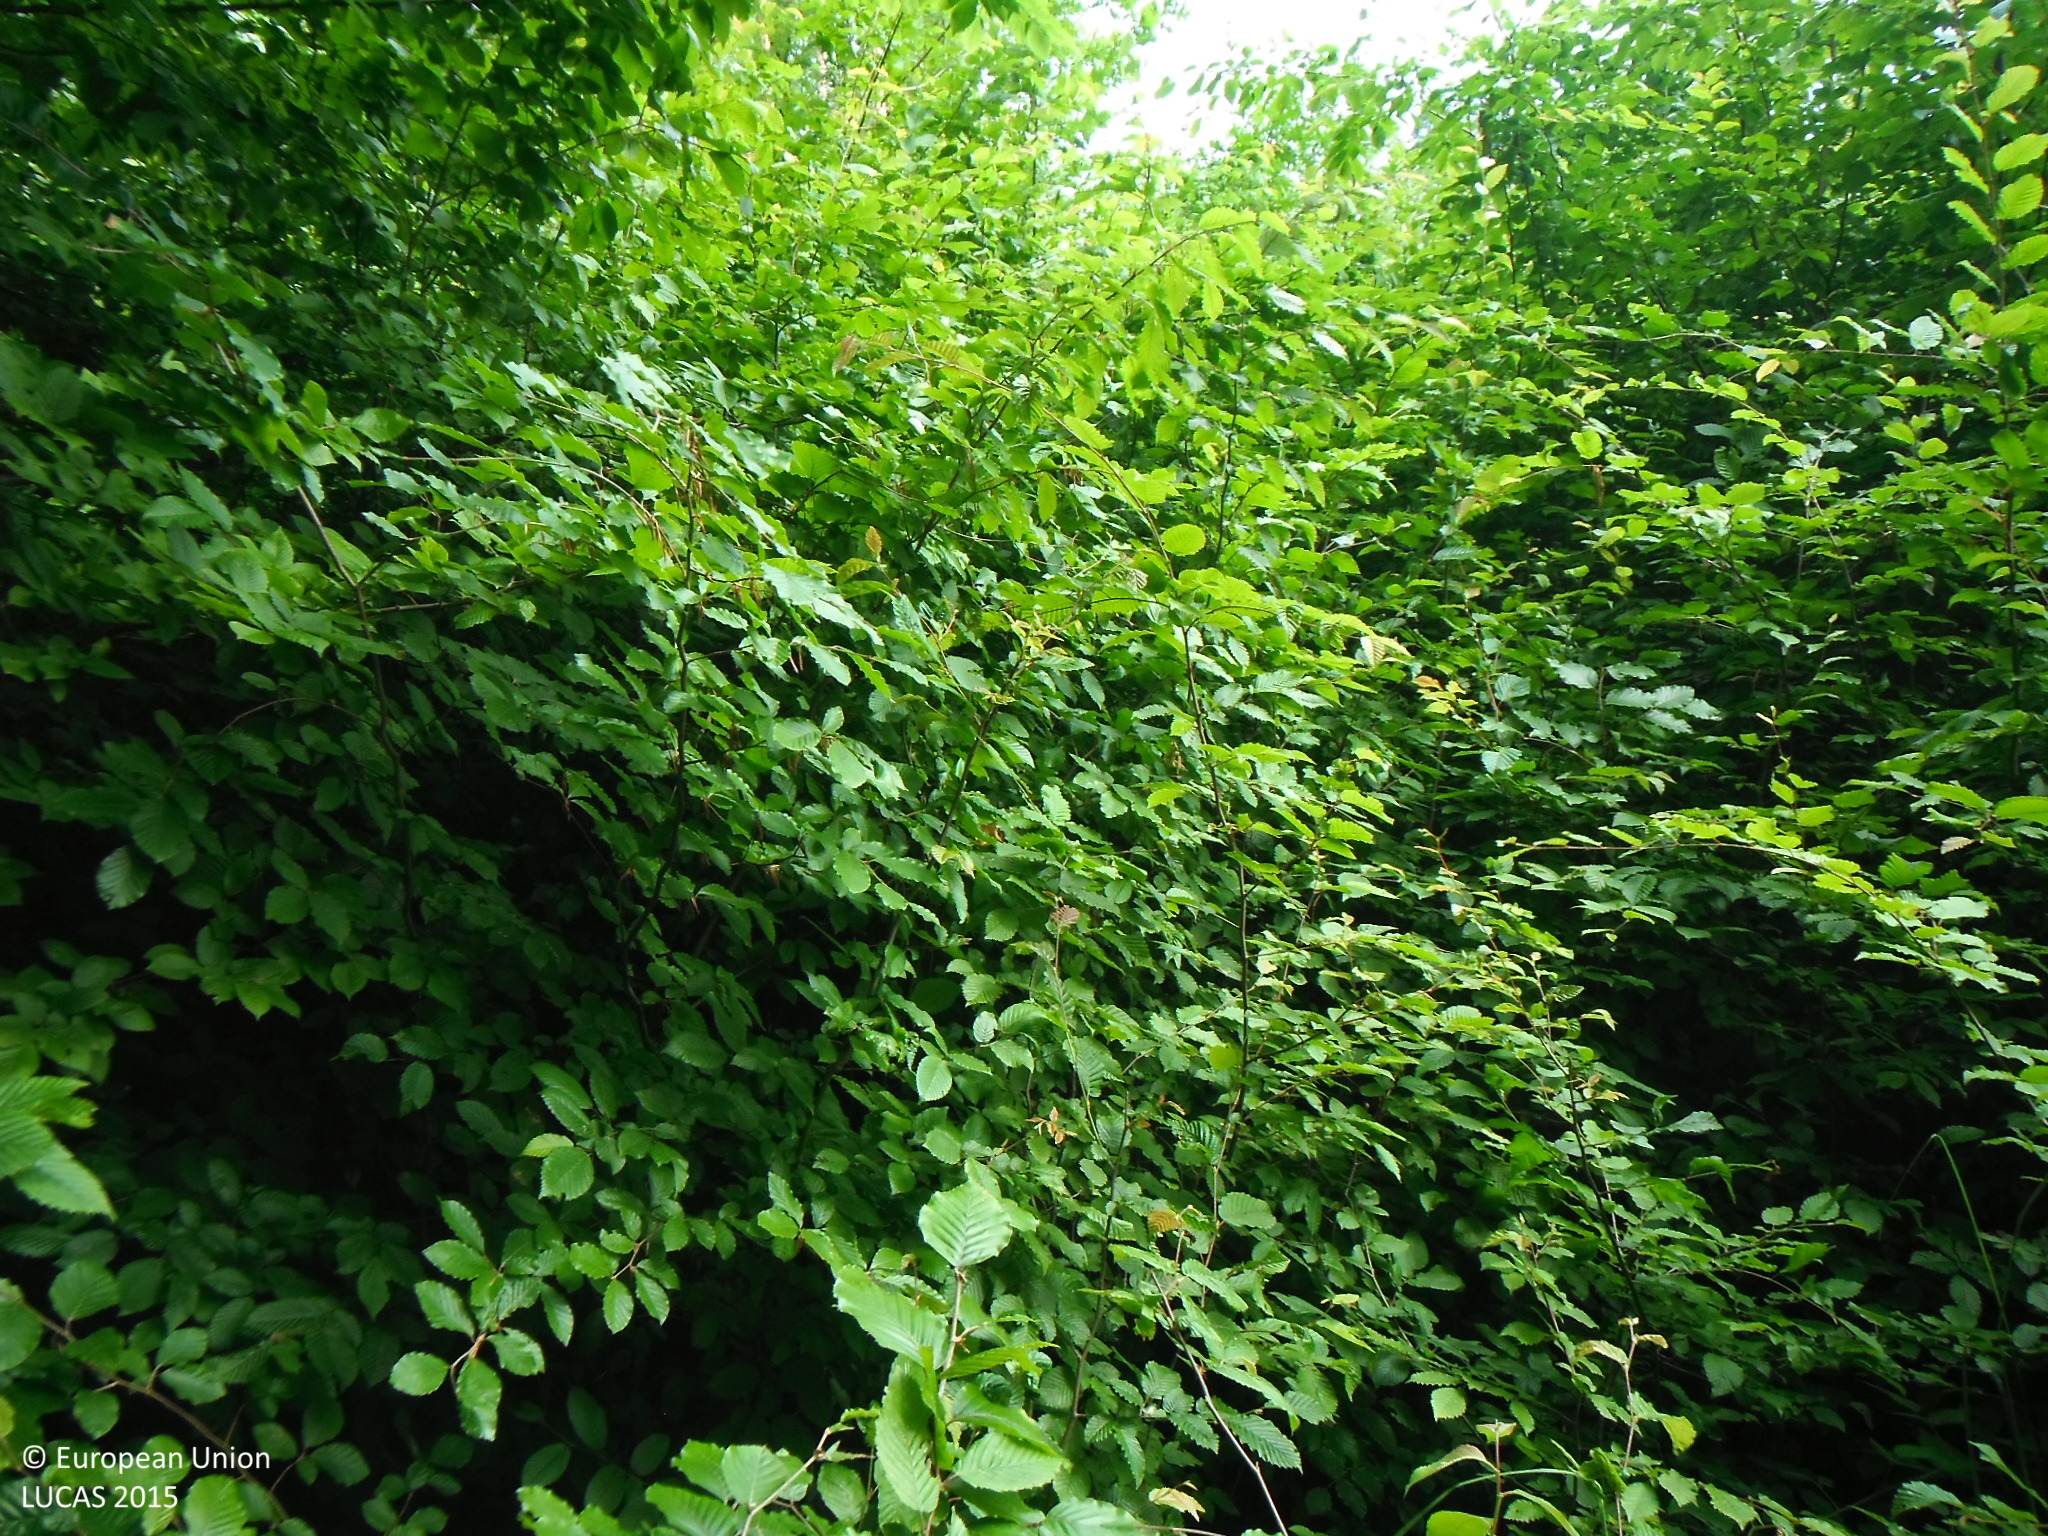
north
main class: Woodland
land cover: Broadleaved woodland
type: beech forest
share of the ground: > 75 %
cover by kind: broadleaved forest trees 75 %, shrubs 25 %
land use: Forestry
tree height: > 5 m
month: June
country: SK
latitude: 49.0919
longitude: 22.0109
